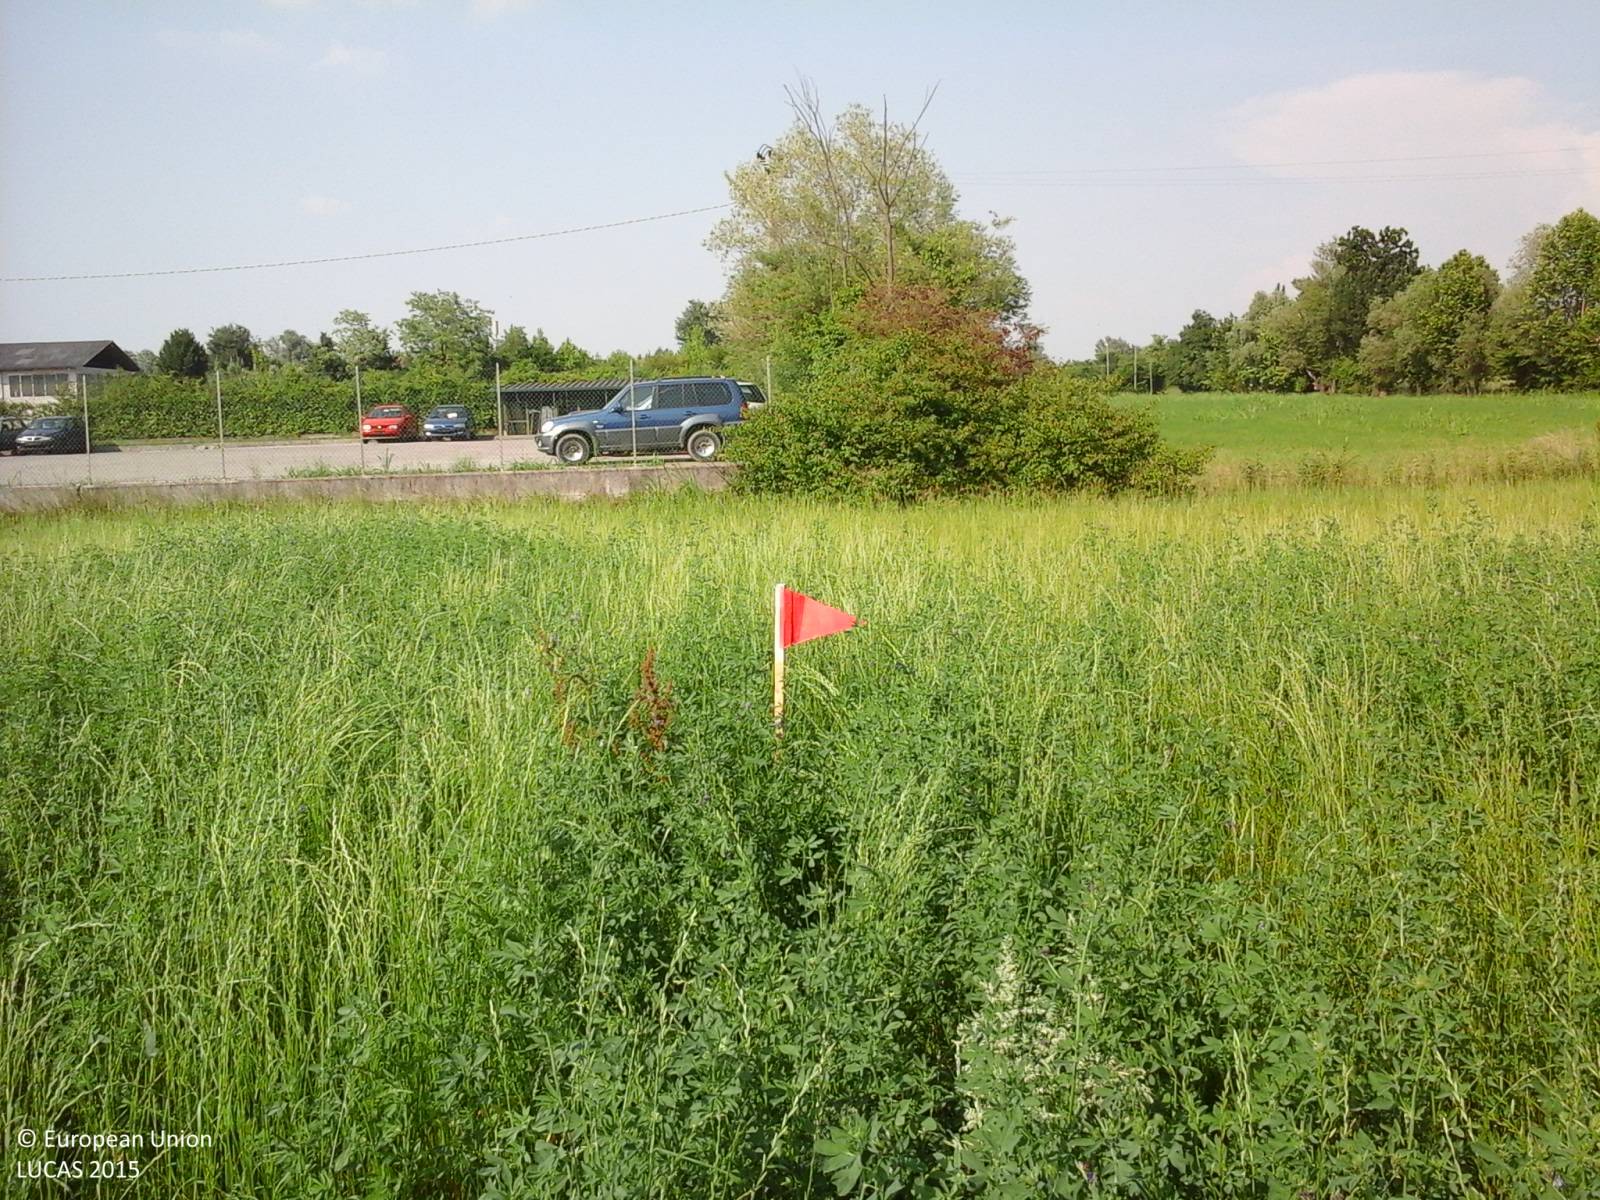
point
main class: Cropland
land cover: Lucerne
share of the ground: > 75 %
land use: Agriculture (excluding fallow land and kitchen gardens)
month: June
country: IT
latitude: 45.9221
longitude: 12.6399
